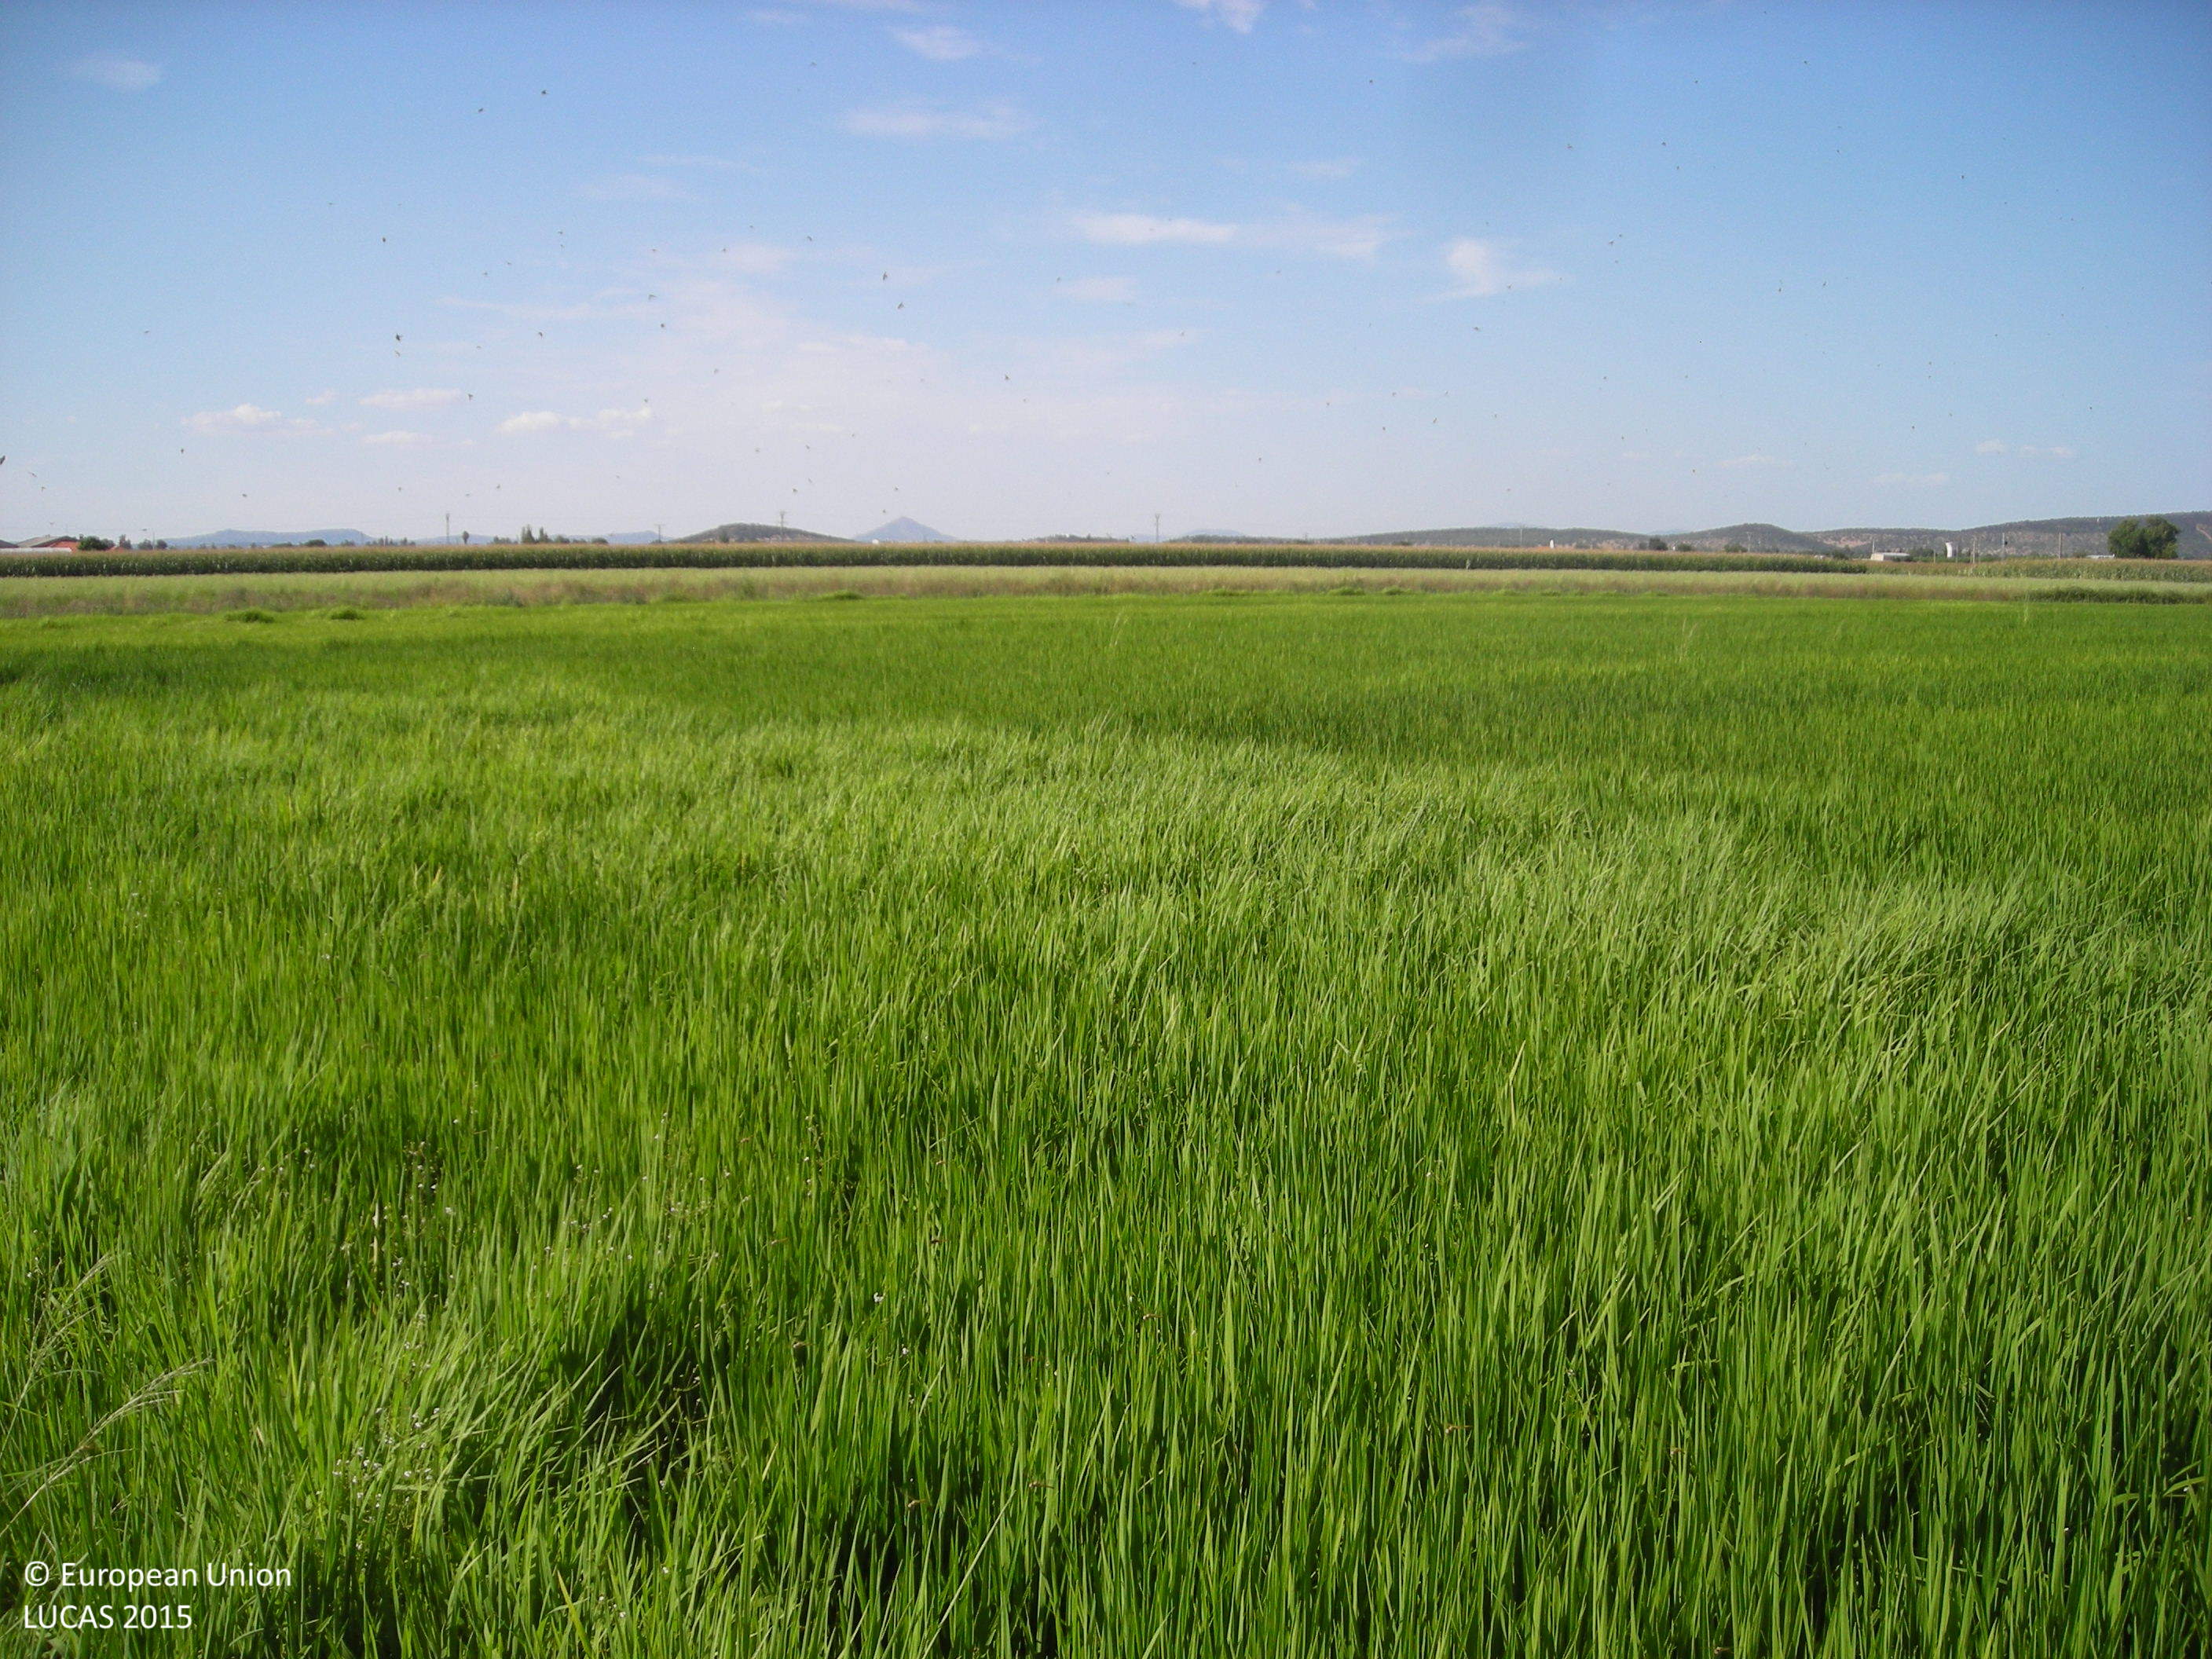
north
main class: Cropland
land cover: Rice
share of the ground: > 75 %
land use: Agriculture (excluding fallow land and kitchen gardens)
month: July
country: ES
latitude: 39.0189
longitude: -5.8856
